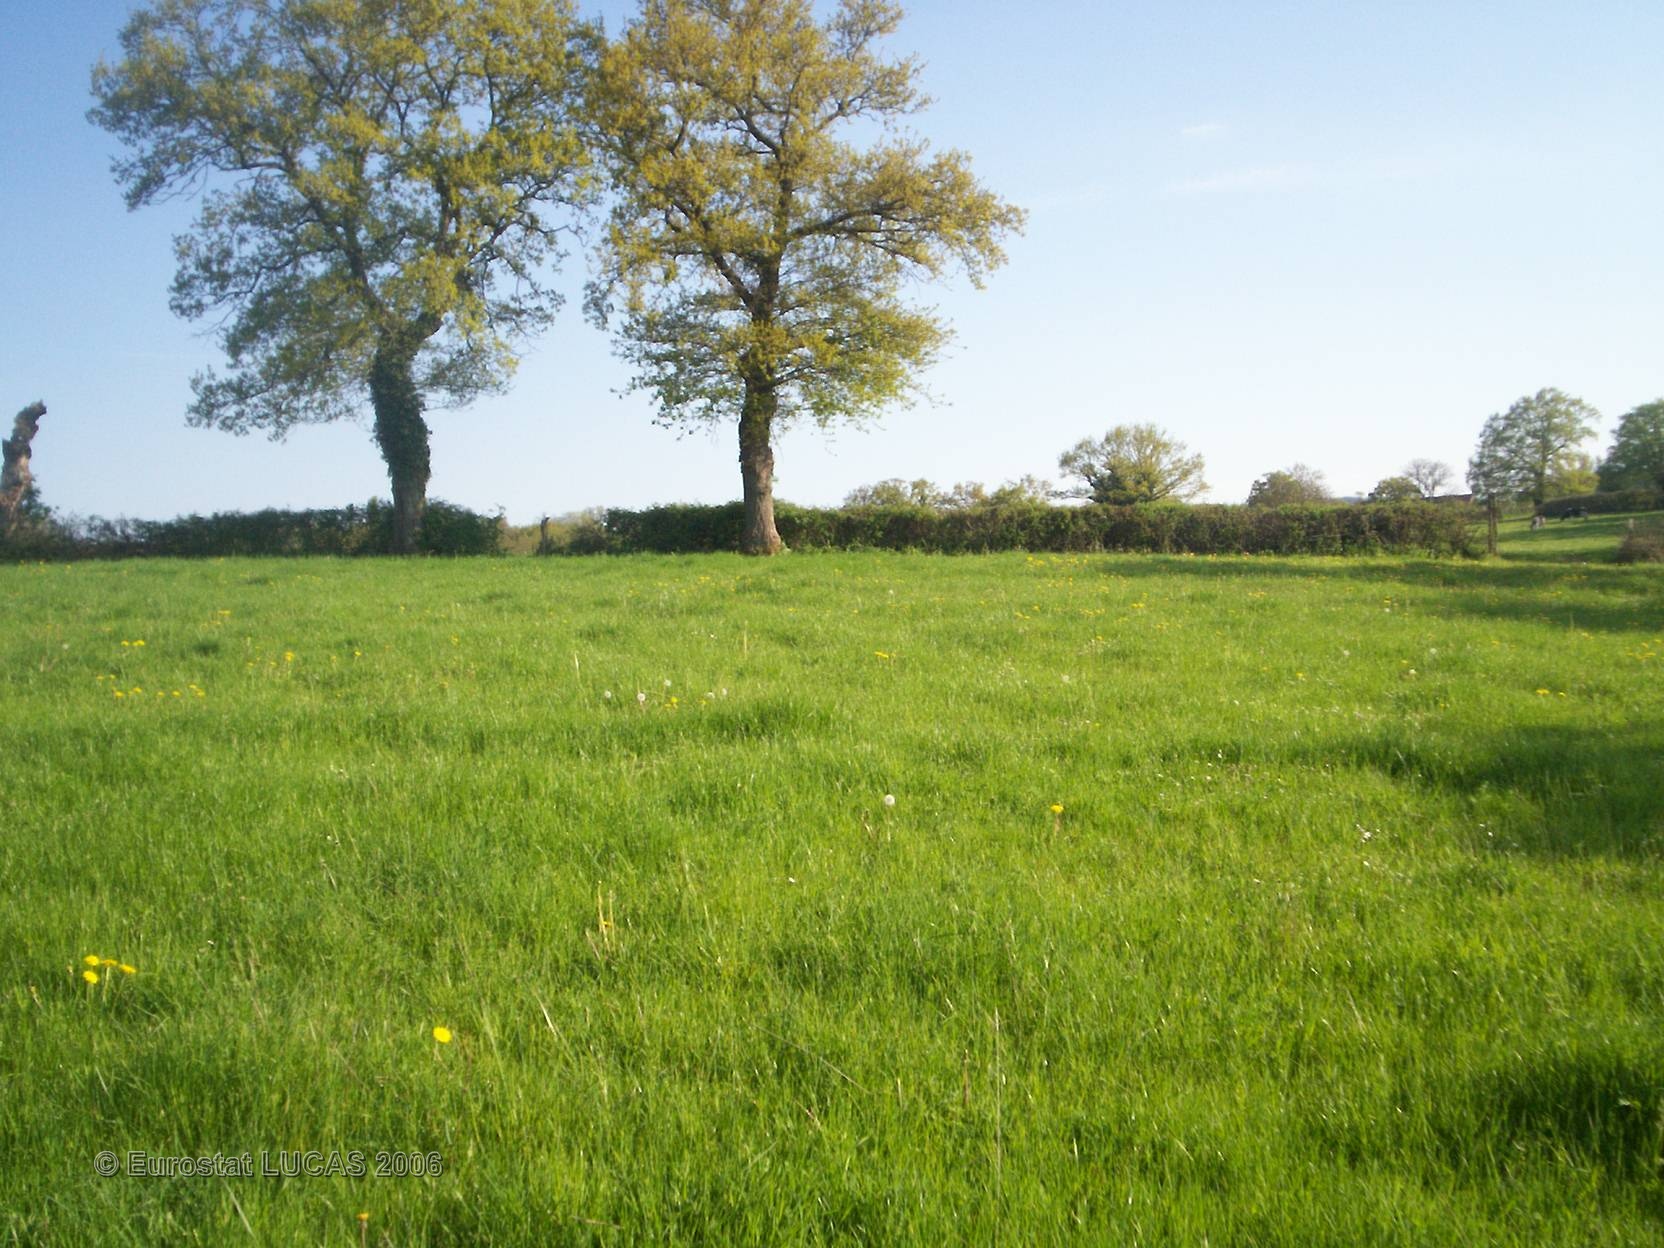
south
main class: Grassland
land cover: Grassland without tree/shrub cover
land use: Agriculture (excluding fallow land and kitchen gardens)
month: May
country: FR
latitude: 46.2291
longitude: 2.9833
